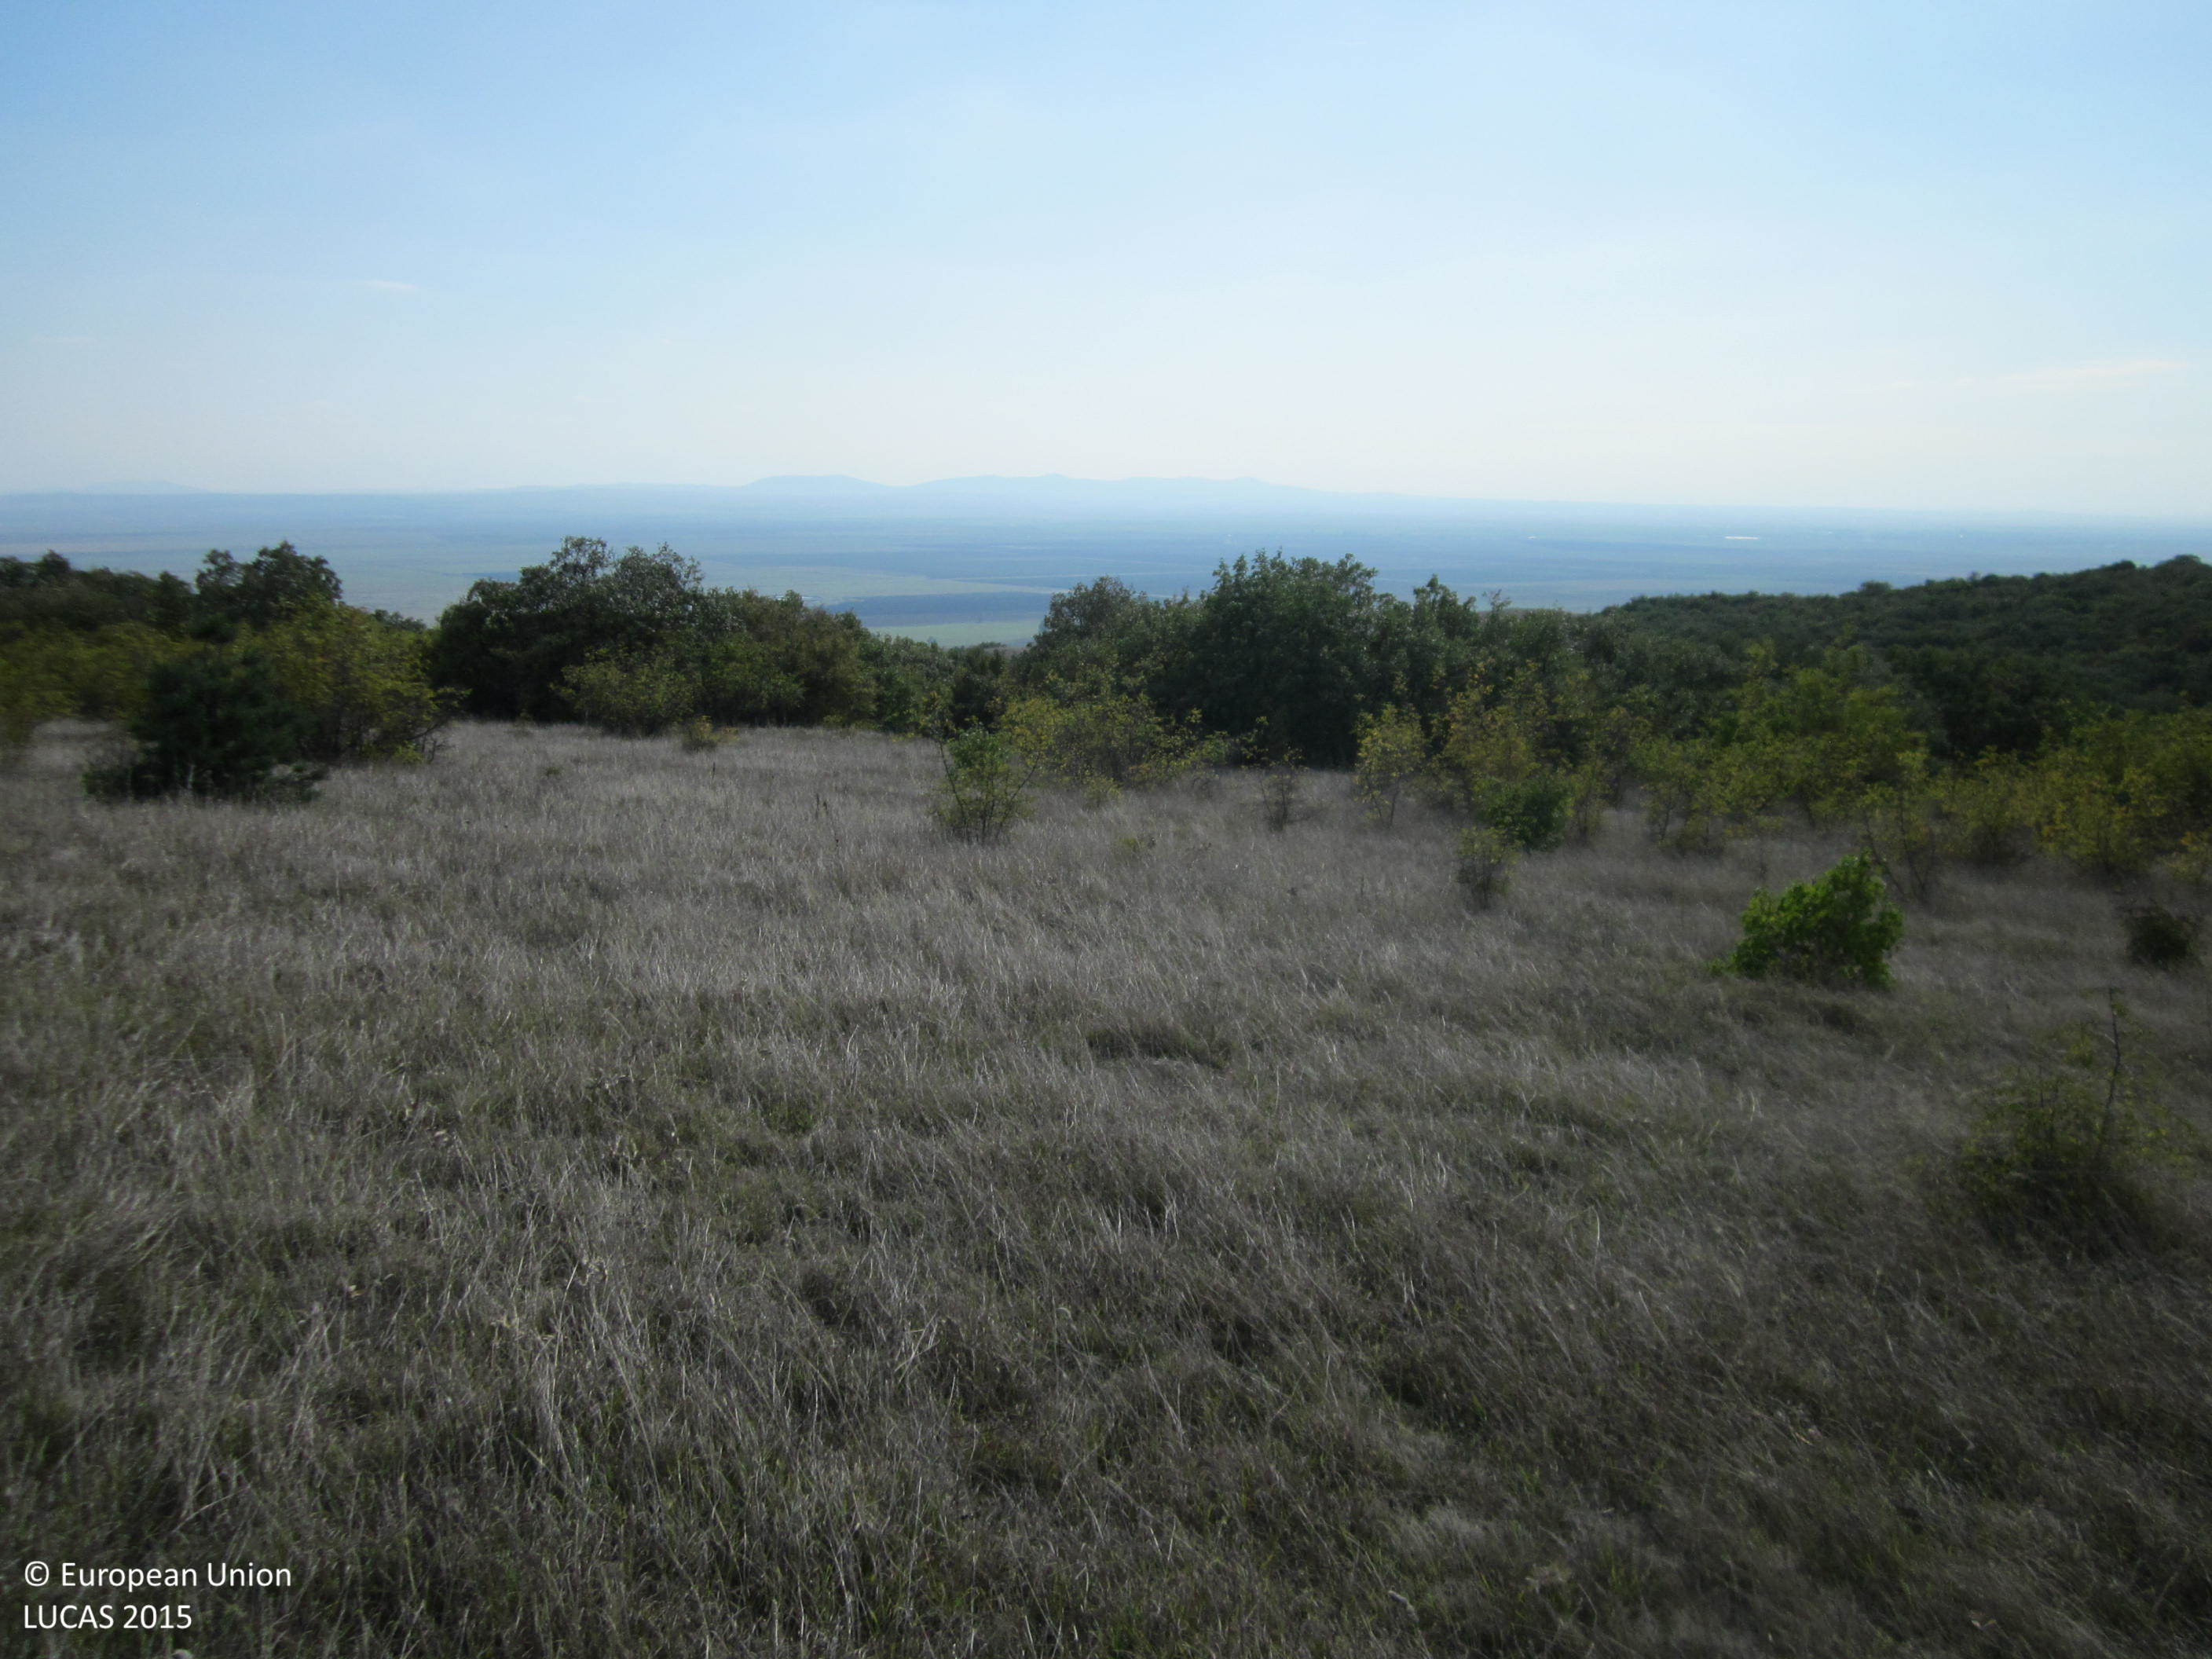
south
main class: Grassland
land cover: Grassland with sparse tree/shrub cover
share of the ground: > 75 %
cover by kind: herbaceous plants 90 %, coniferous forest trees 5 %, shrubs 5 %
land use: Semi-natural and natural areas not in use
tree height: < 5 m
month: October
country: BG
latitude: 42.6598
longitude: 26.7781
